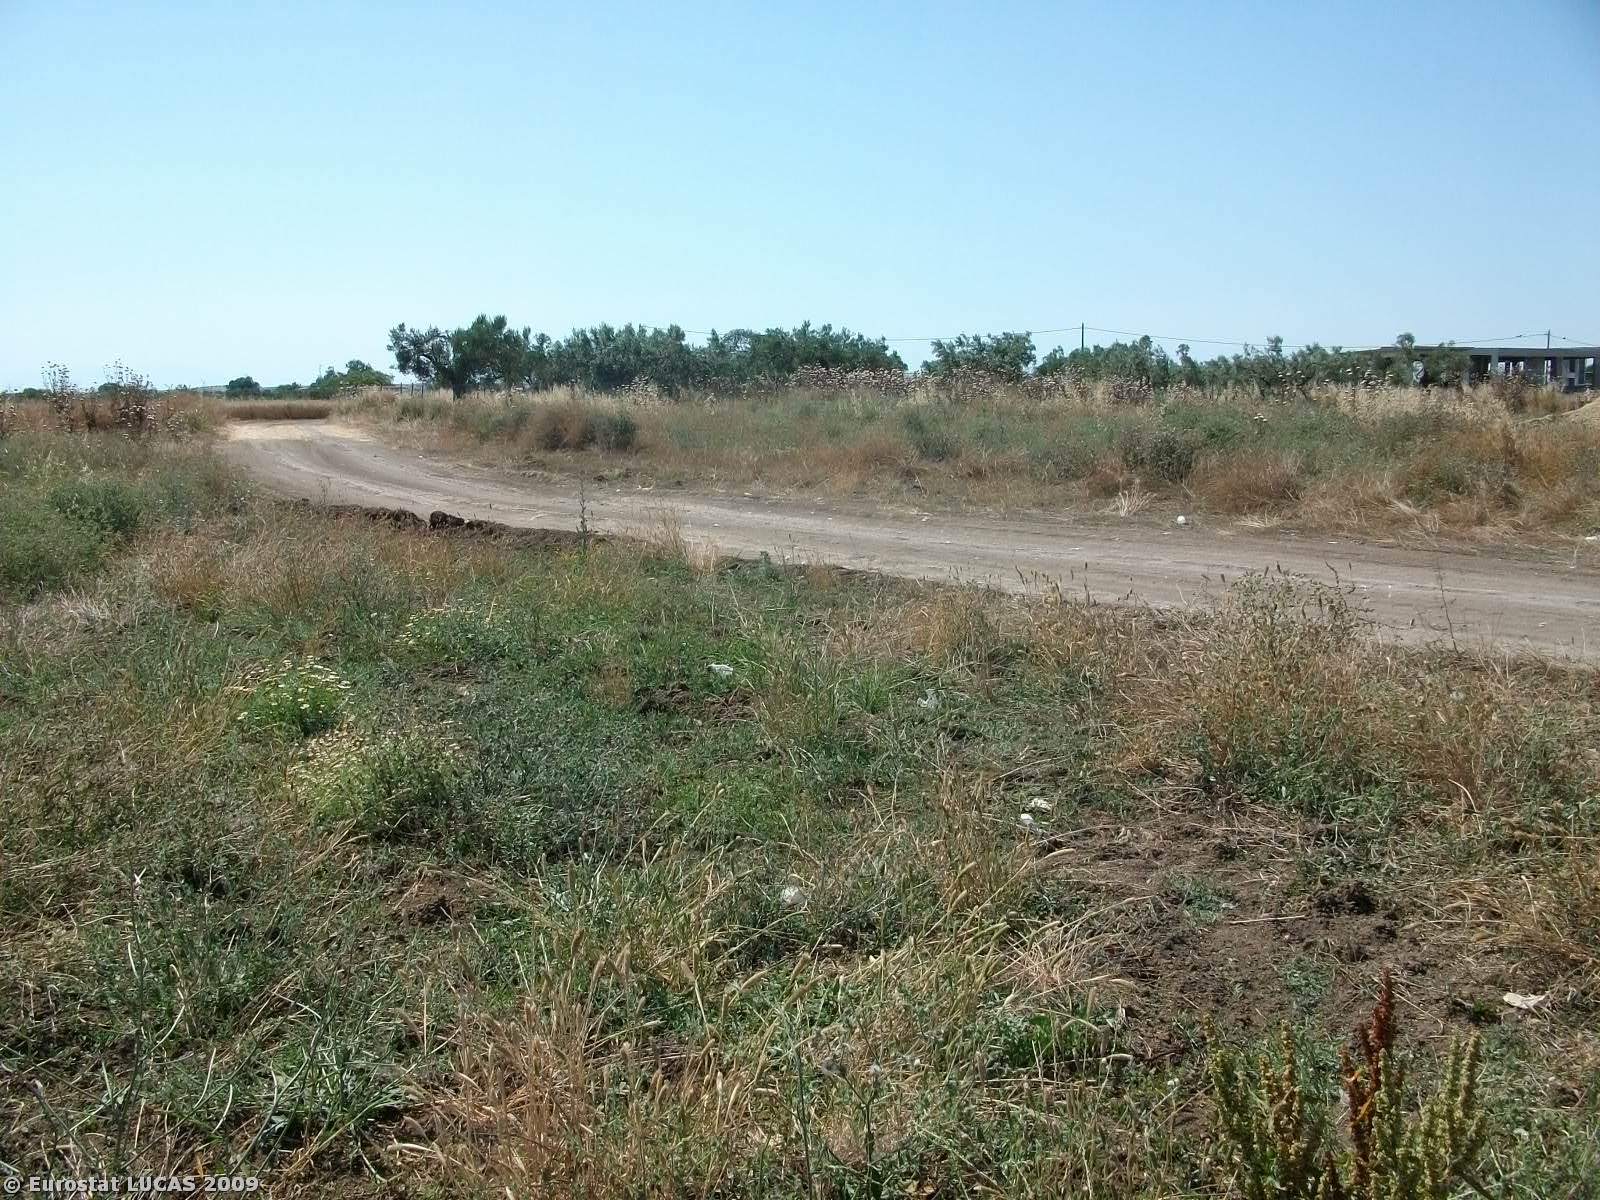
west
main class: Grassland
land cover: Grassland without tree/shrub cover
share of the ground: > 75 %
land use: Unused
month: June
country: GR
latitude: 40.0894
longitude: 23.4356
